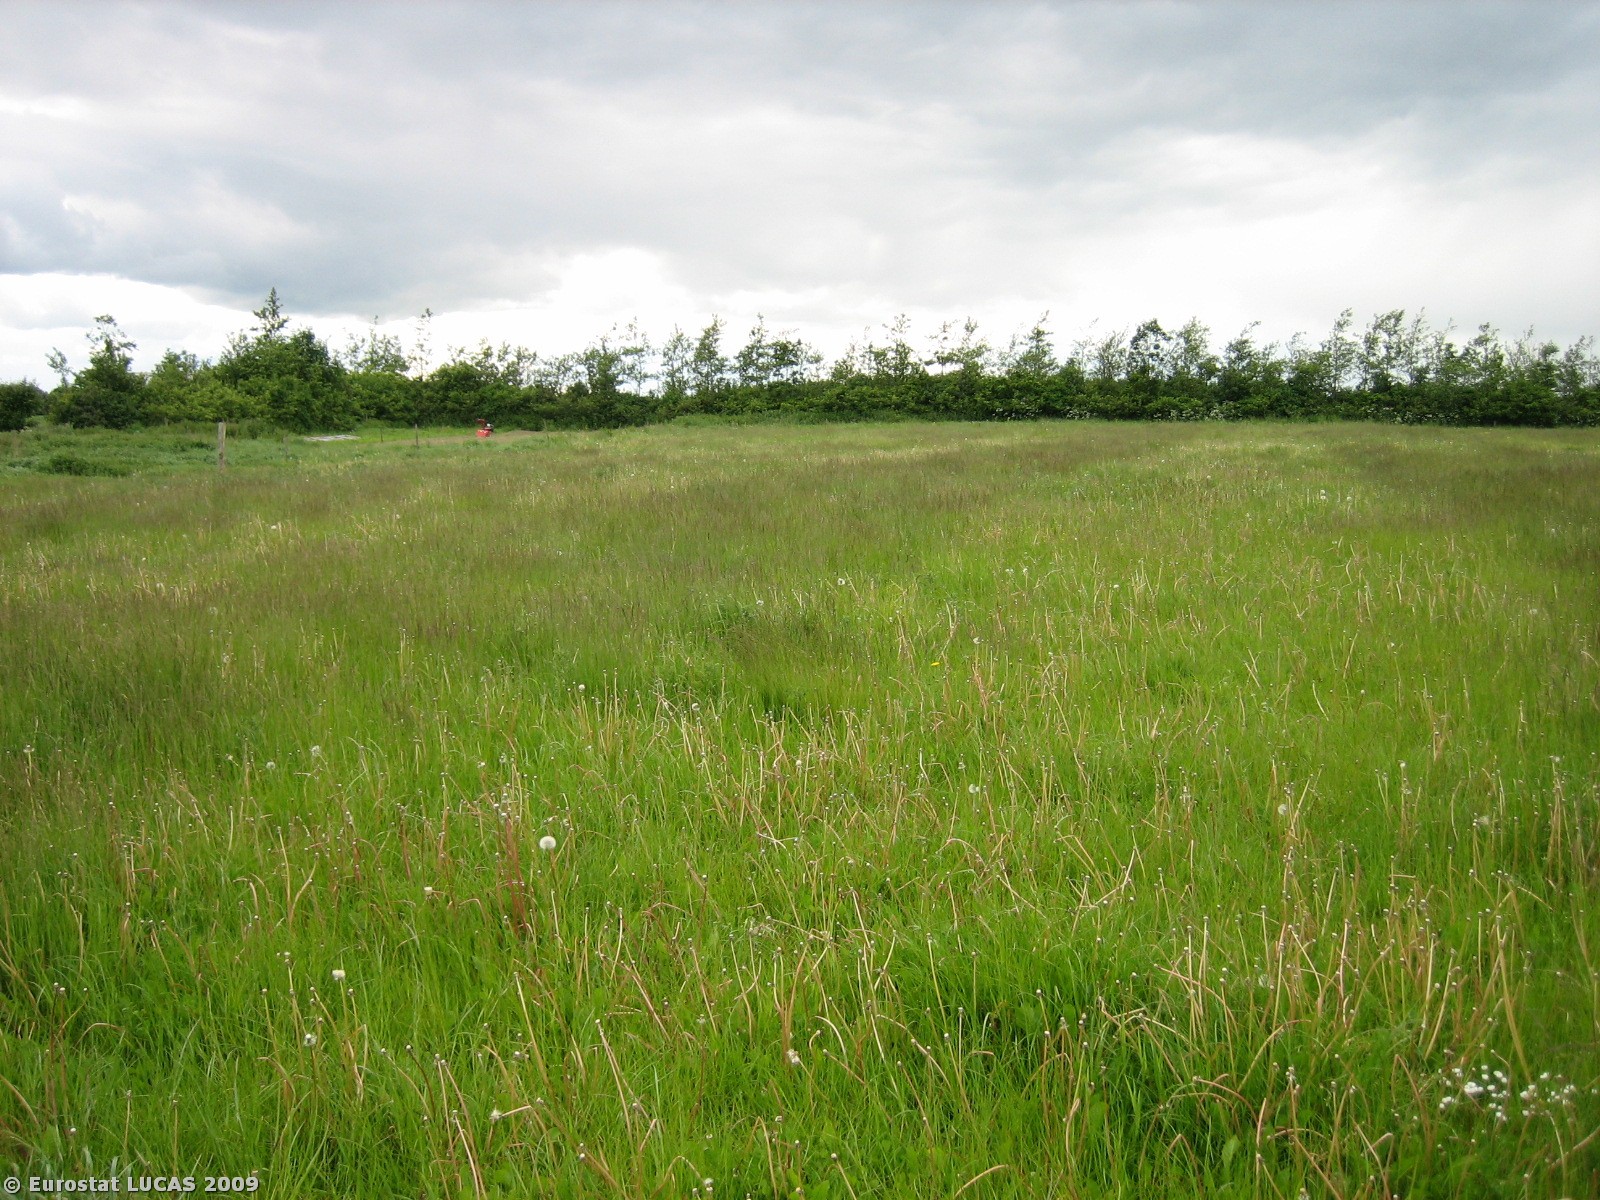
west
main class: Grassland
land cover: Grassland without tree/shrub cover
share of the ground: > 75 %
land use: Agriculture (excluding fallow land and kitchen gardens)
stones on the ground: < 10 %
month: June
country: DK
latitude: 56.2956
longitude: 9.9193
